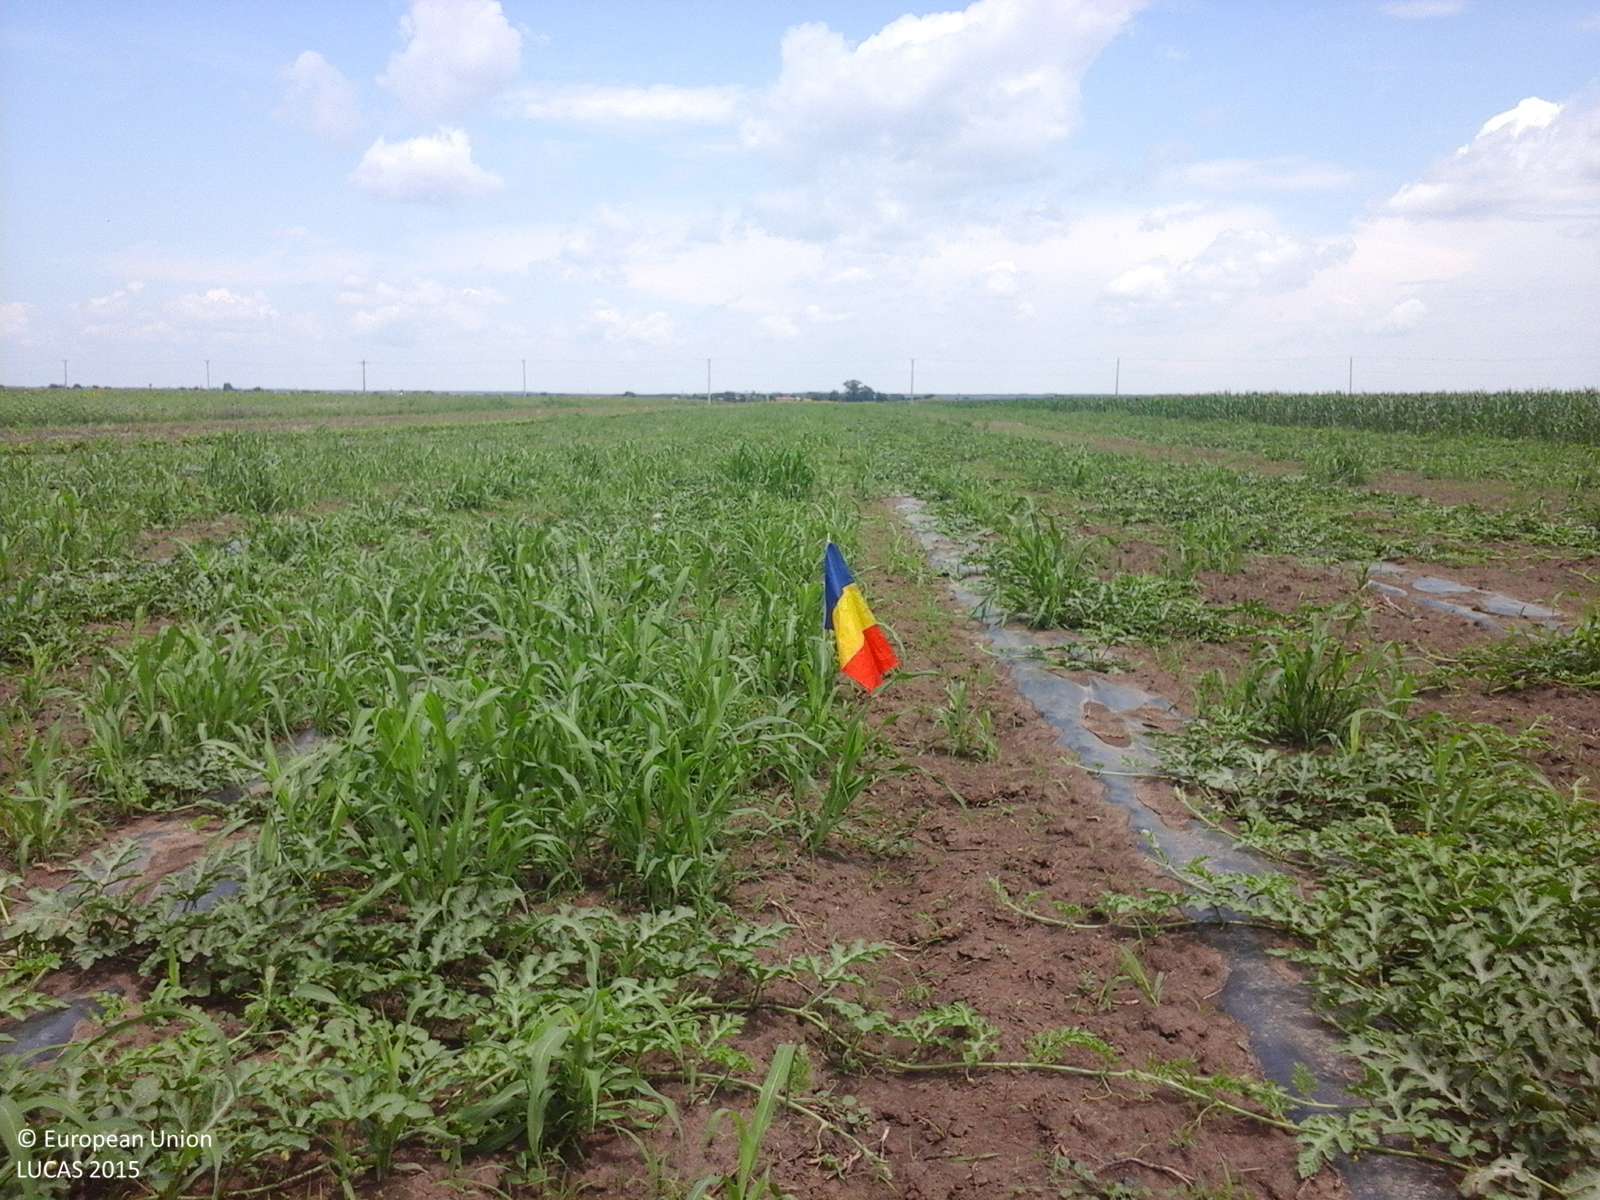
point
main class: Cropland
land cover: Other fresh vegetables
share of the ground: 50 - 75 %
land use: Agriculture (excluding fallow land and kitchen gardens)
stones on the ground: < 10 %
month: July
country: RO
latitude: 44.0530
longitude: 24.5343
